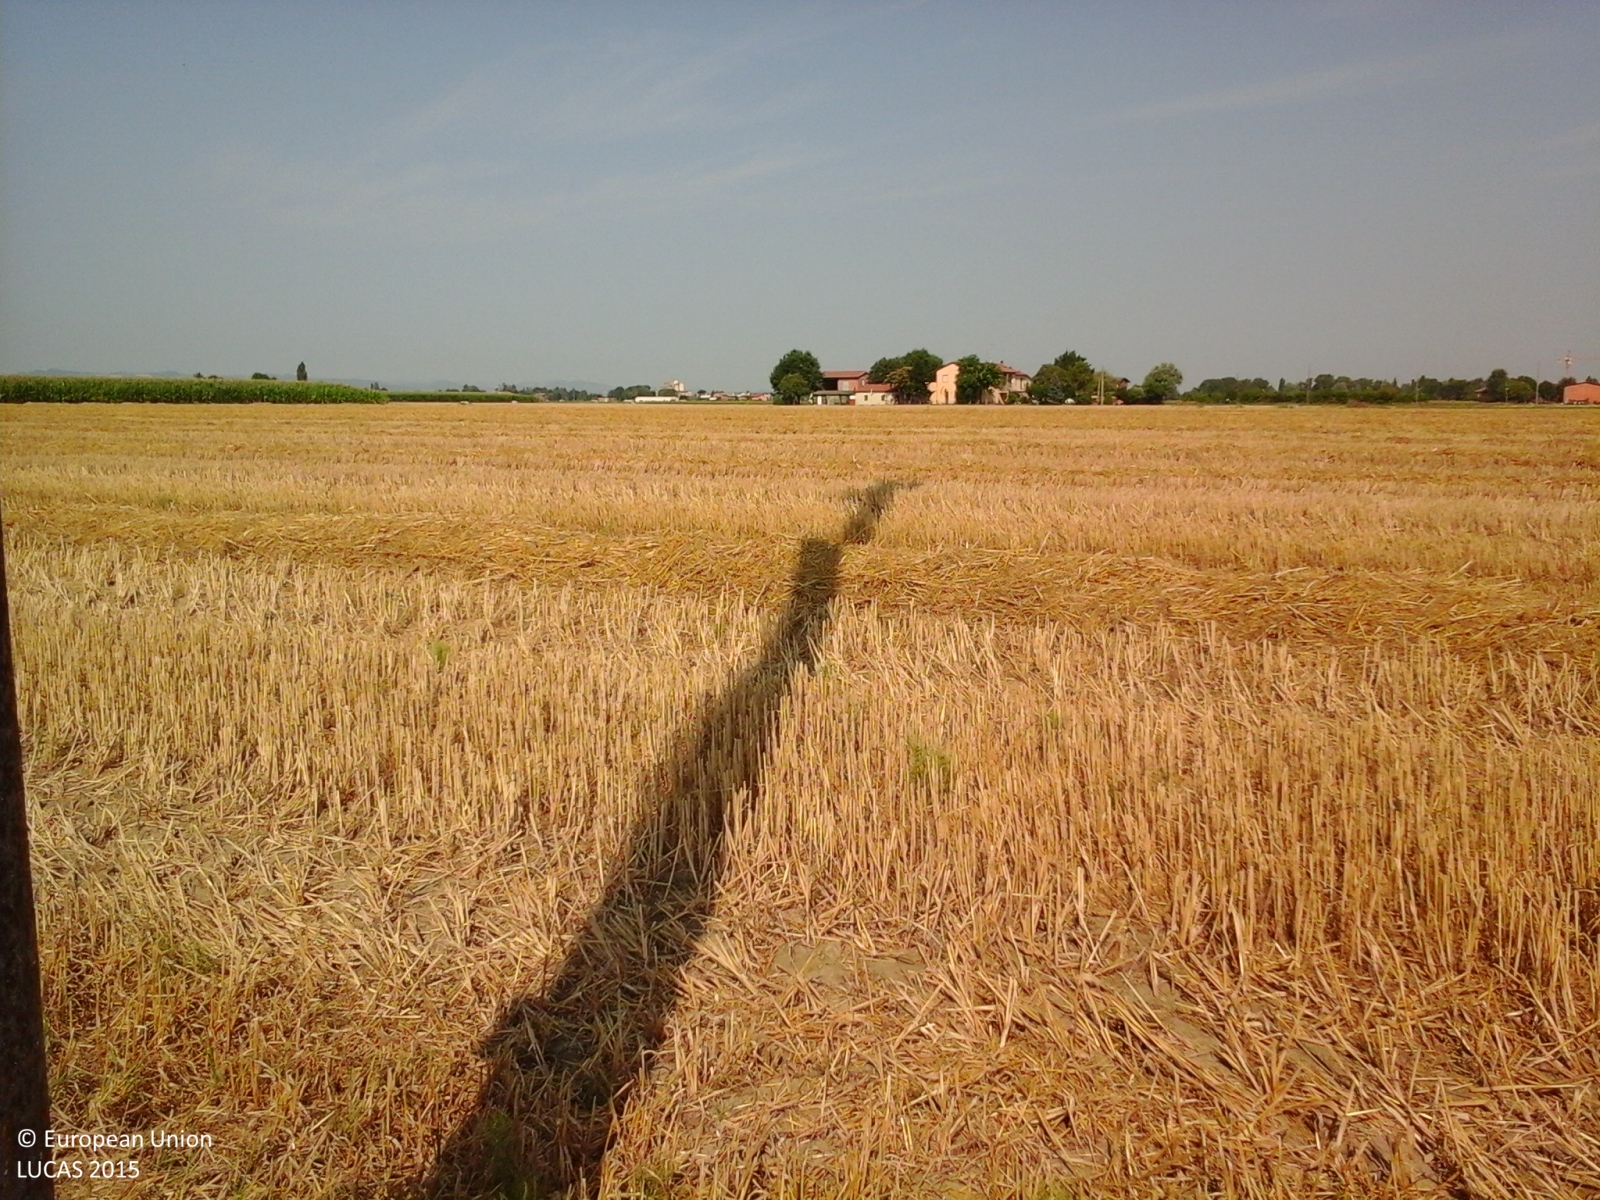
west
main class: Cropland
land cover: Barley
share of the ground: > 75 %
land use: Agriculture (excluding fallow land and kitchen gardens)
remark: Harvested field
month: July
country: IT
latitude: 44.4638
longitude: 11.6430
